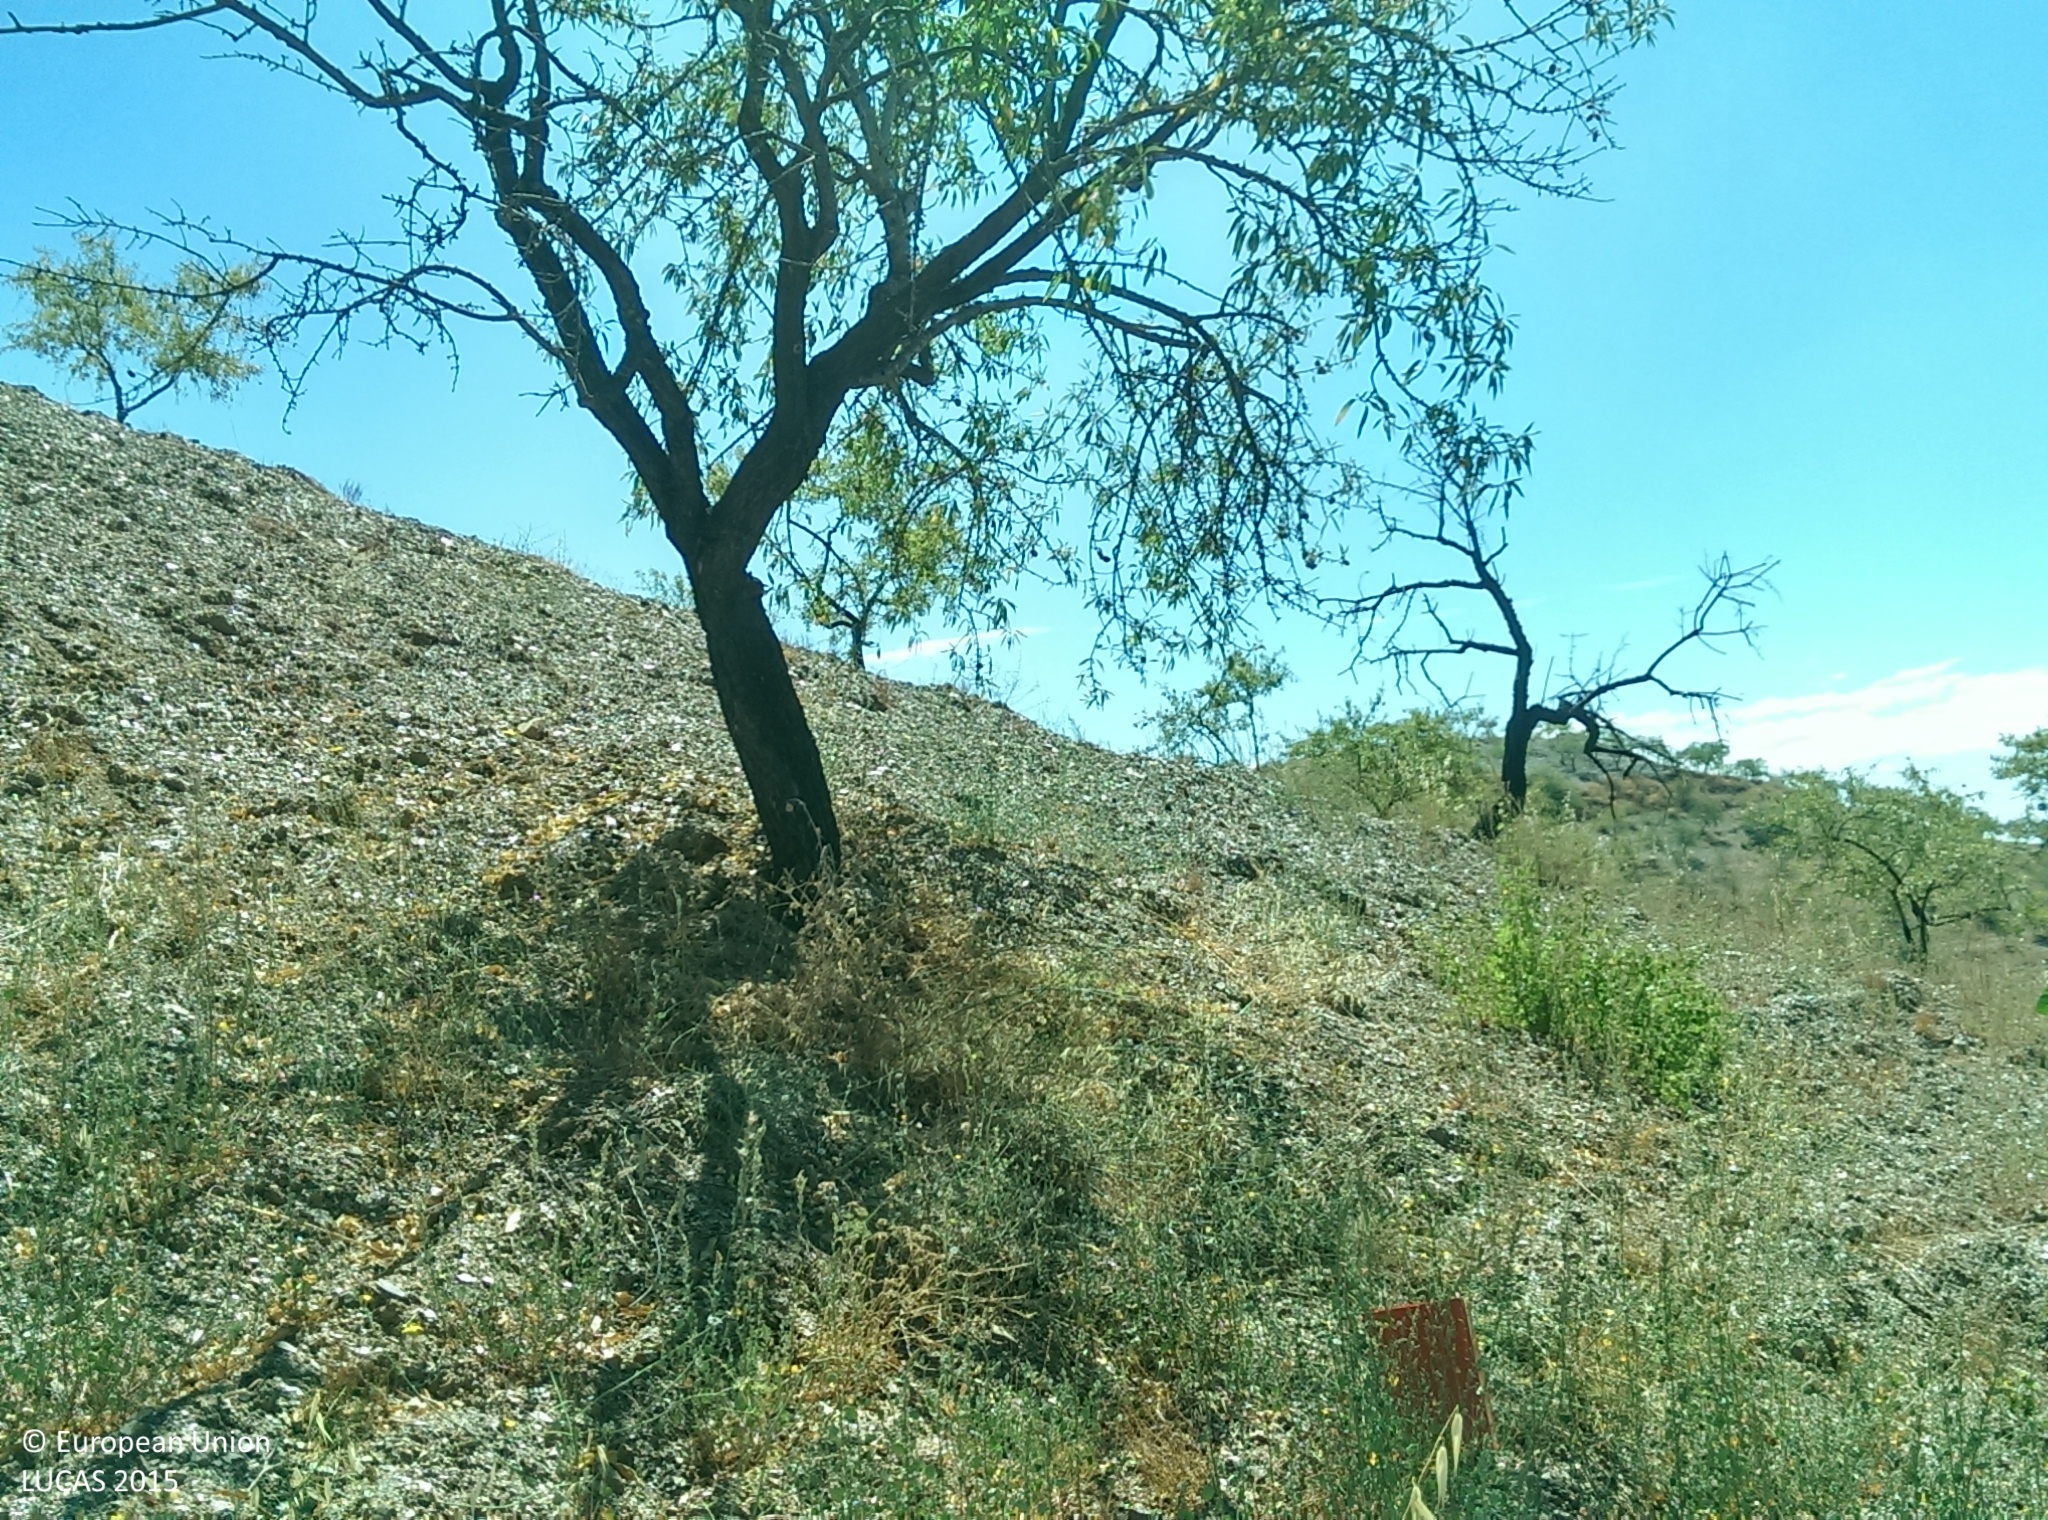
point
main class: Cropland
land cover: Nuts trees
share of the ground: 25 - 50 %
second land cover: Spontaneously vegetated surfaces
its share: 25 - 50 %
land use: Agriculture (excluding fallow land and kitchen gardens)
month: August
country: ES
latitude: 36.8295
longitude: -3.1539
